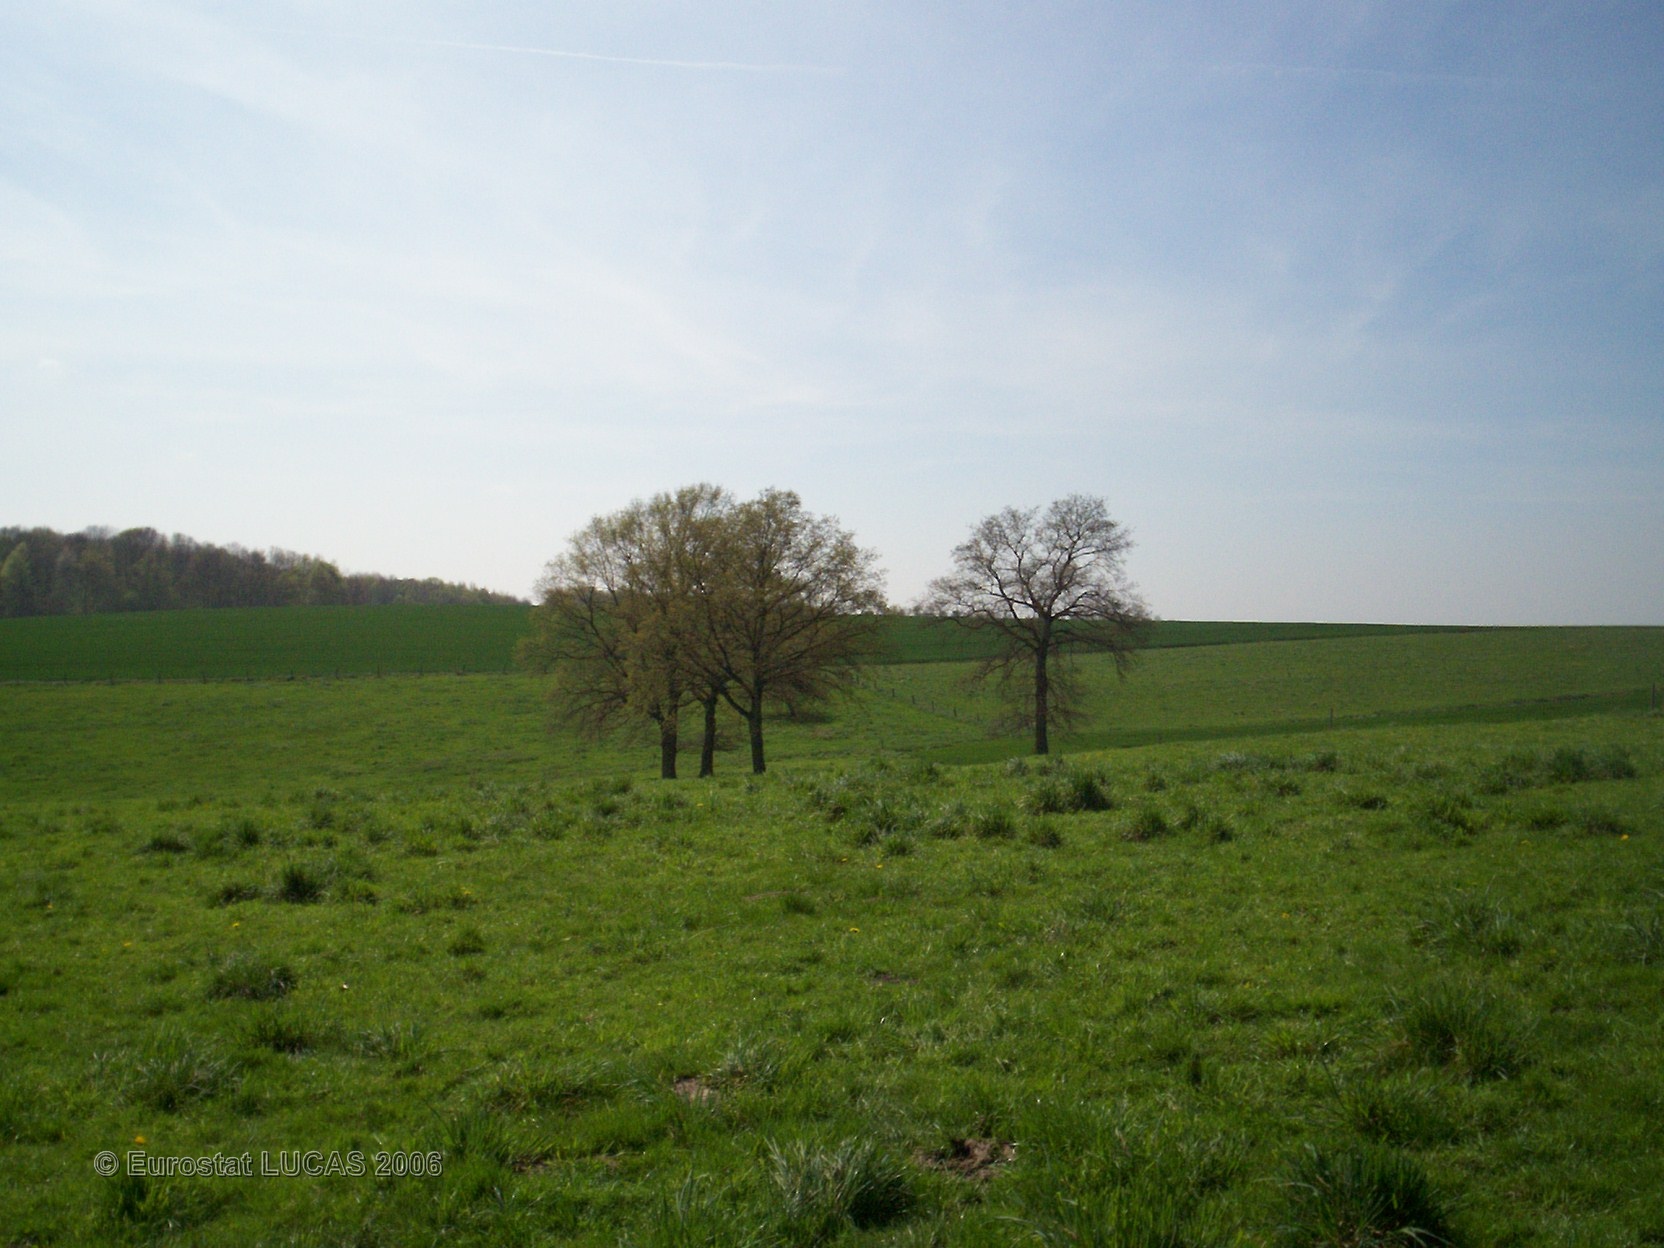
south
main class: Grassland
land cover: Grassland without tree/shrub cover
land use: Agriculture (excluding fallow land and kitchen gardens)
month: April
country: FR
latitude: 49.6508
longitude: 4.4141
